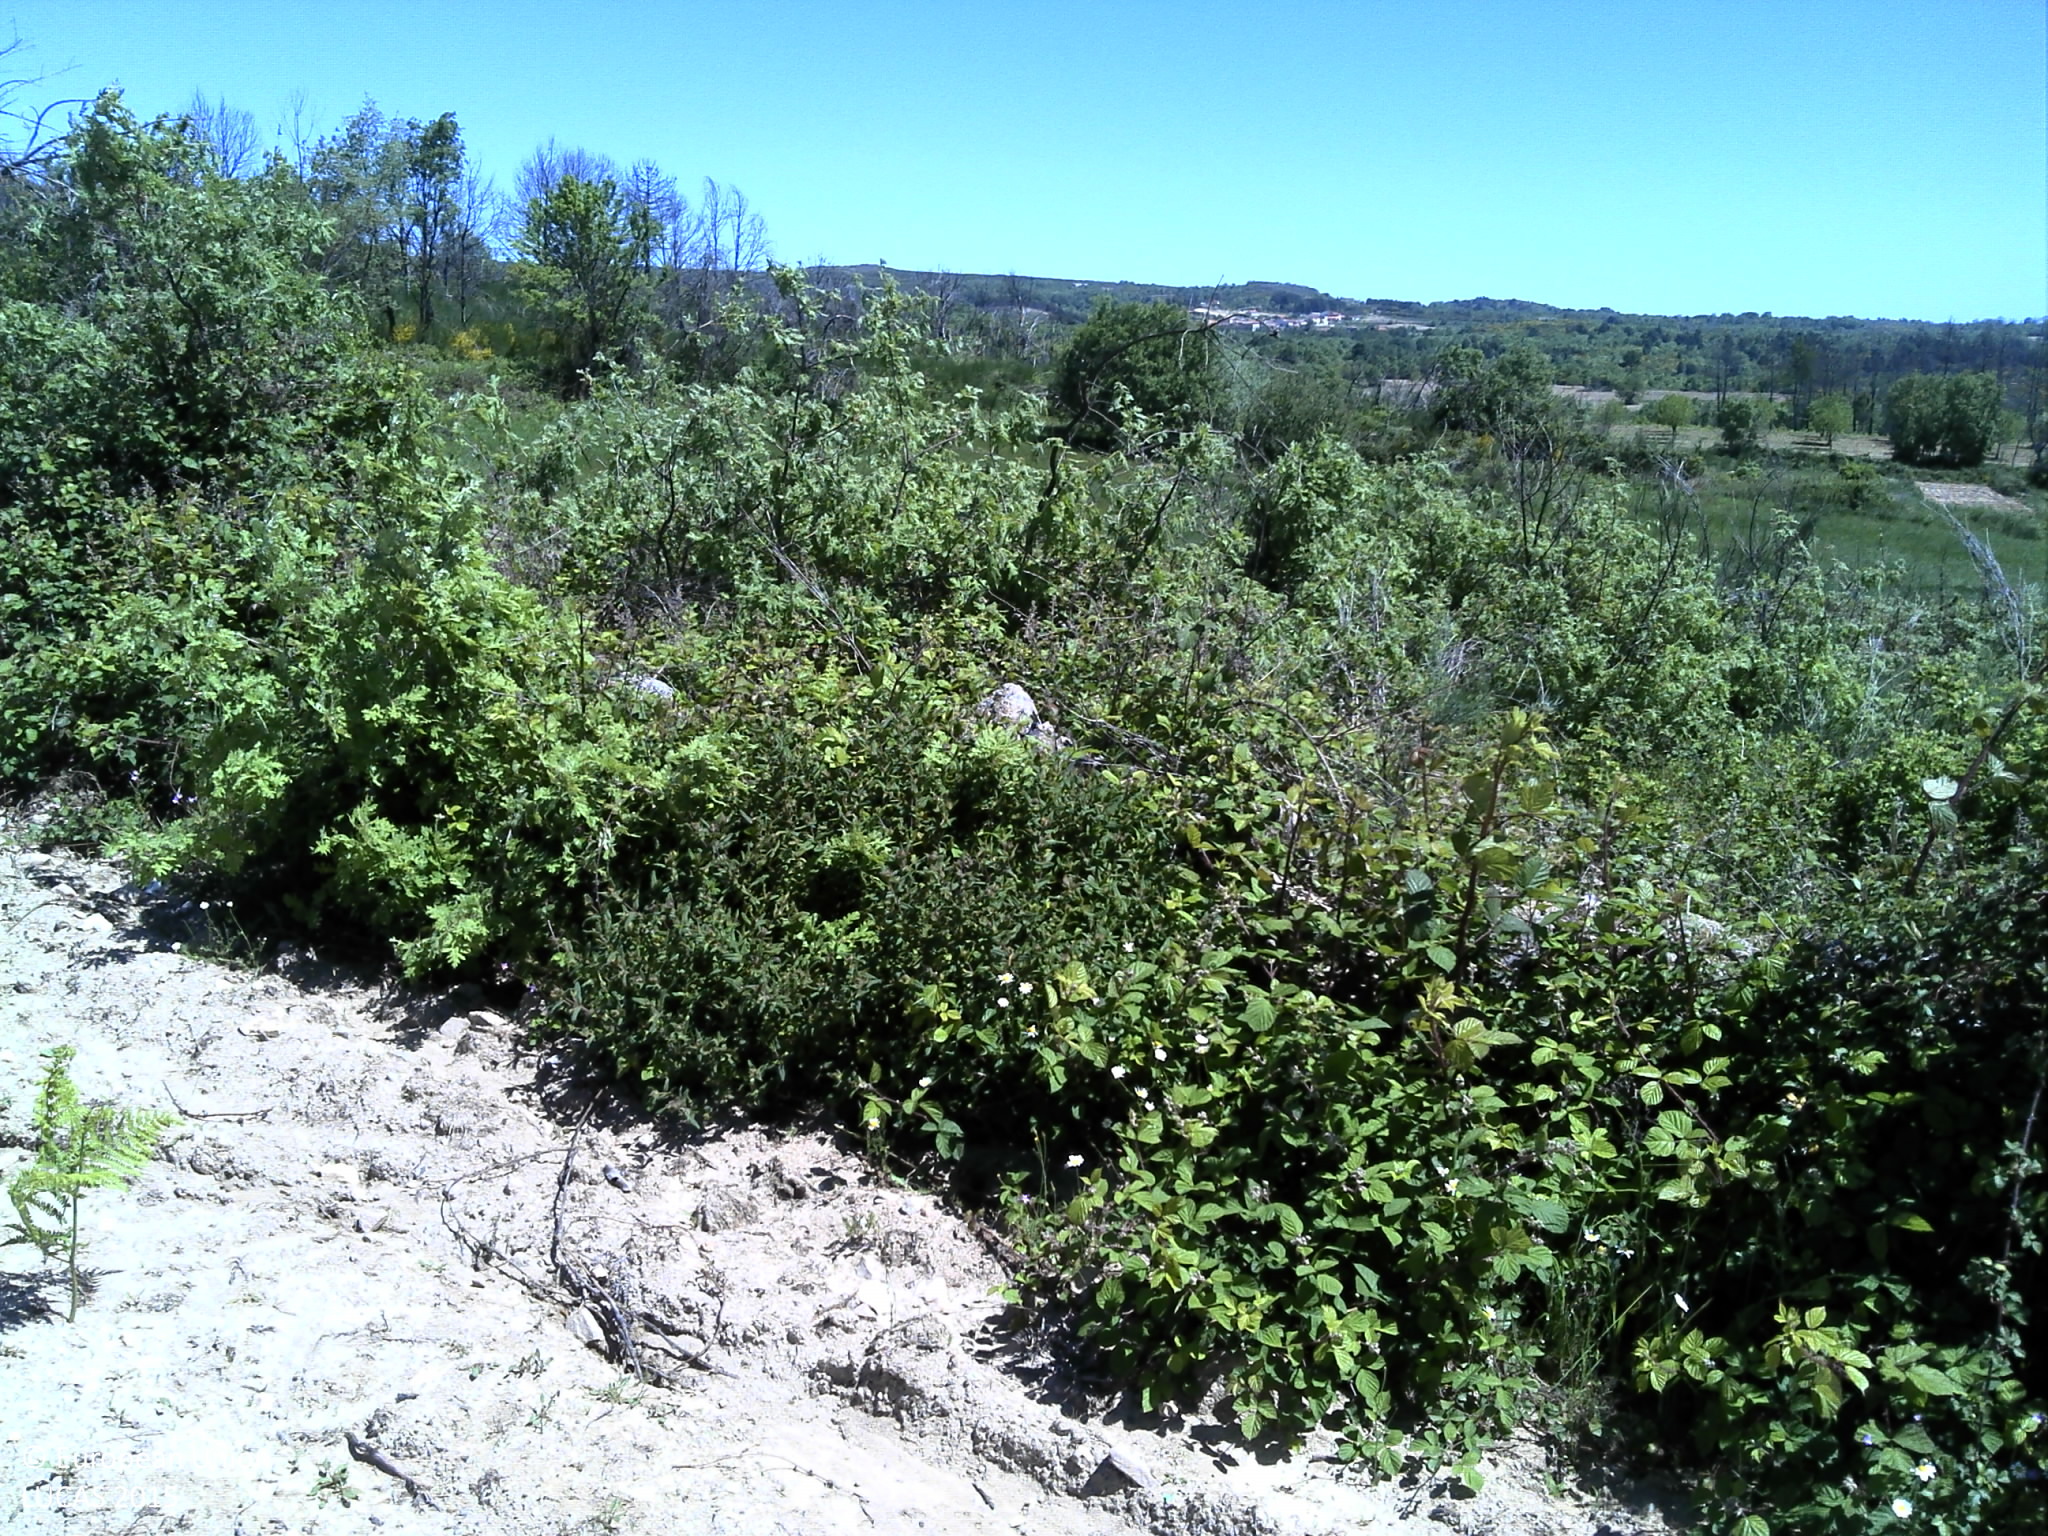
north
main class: Cropland
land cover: Nuts trees
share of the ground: < 10 %
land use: Agriculture (excluding fallow land and kitchen gardens)
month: May
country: PT
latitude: 41.7361
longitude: -7.3317
